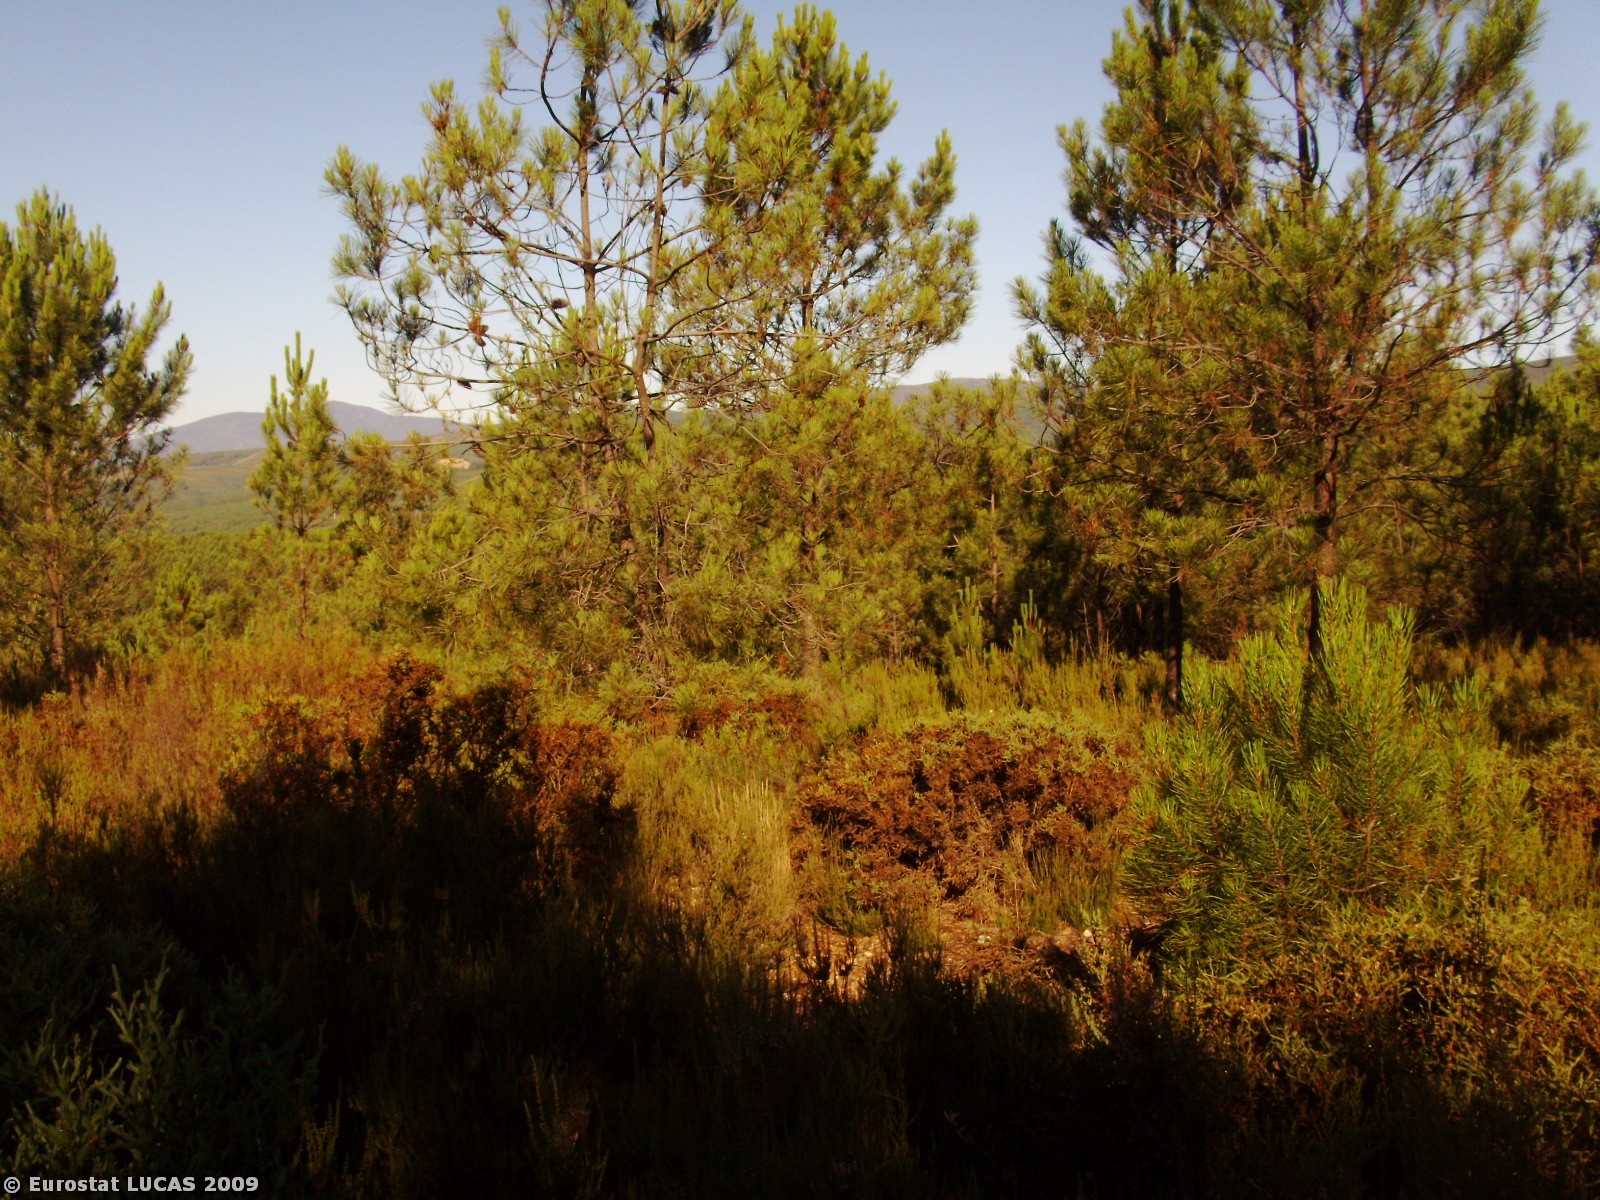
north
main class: Woodland
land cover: Coniferous woodland
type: coniferous forest of the mediterranean region
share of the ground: > 75 %
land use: Forestry
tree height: > 5 m
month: July
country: PT
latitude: 40.2256
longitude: -7.6318
